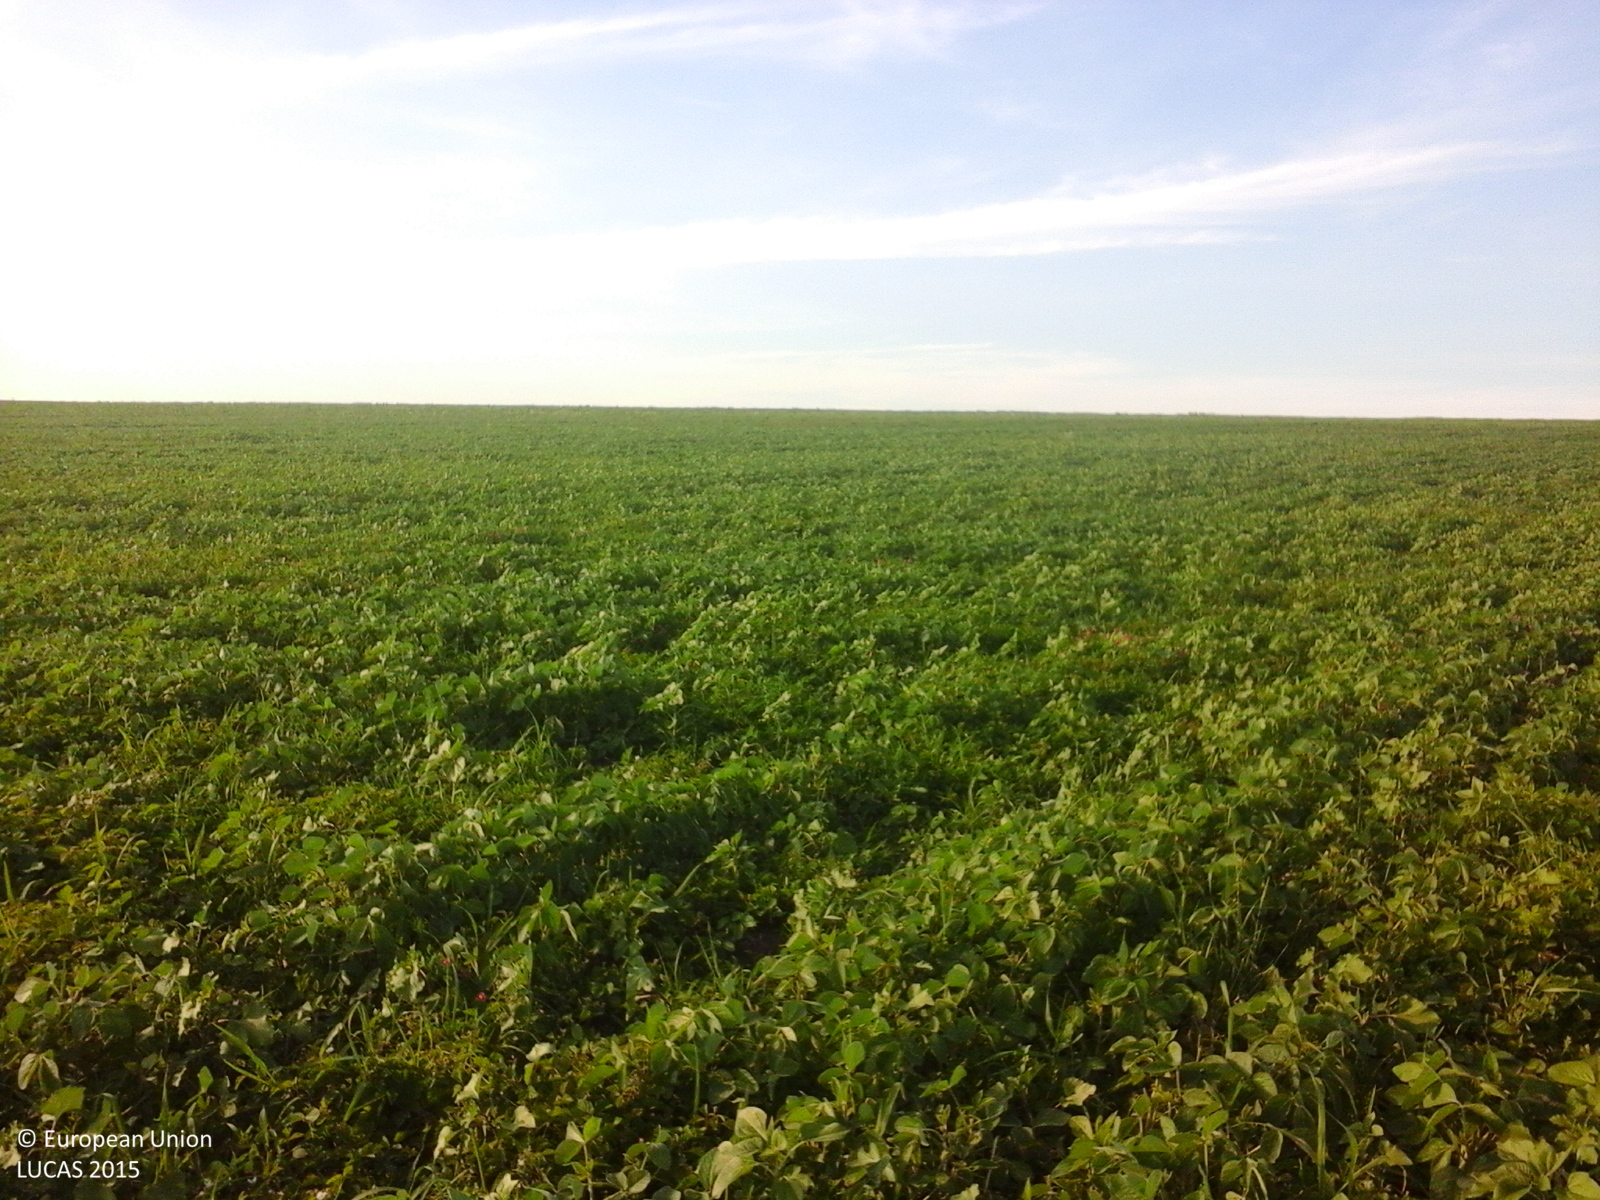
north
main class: Cropland
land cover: Soya
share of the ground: > 75 %
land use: Agriculture (excluding fallow land and kitchen gardens)
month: June
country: RO
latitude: 48.1033
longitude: 26.7660
